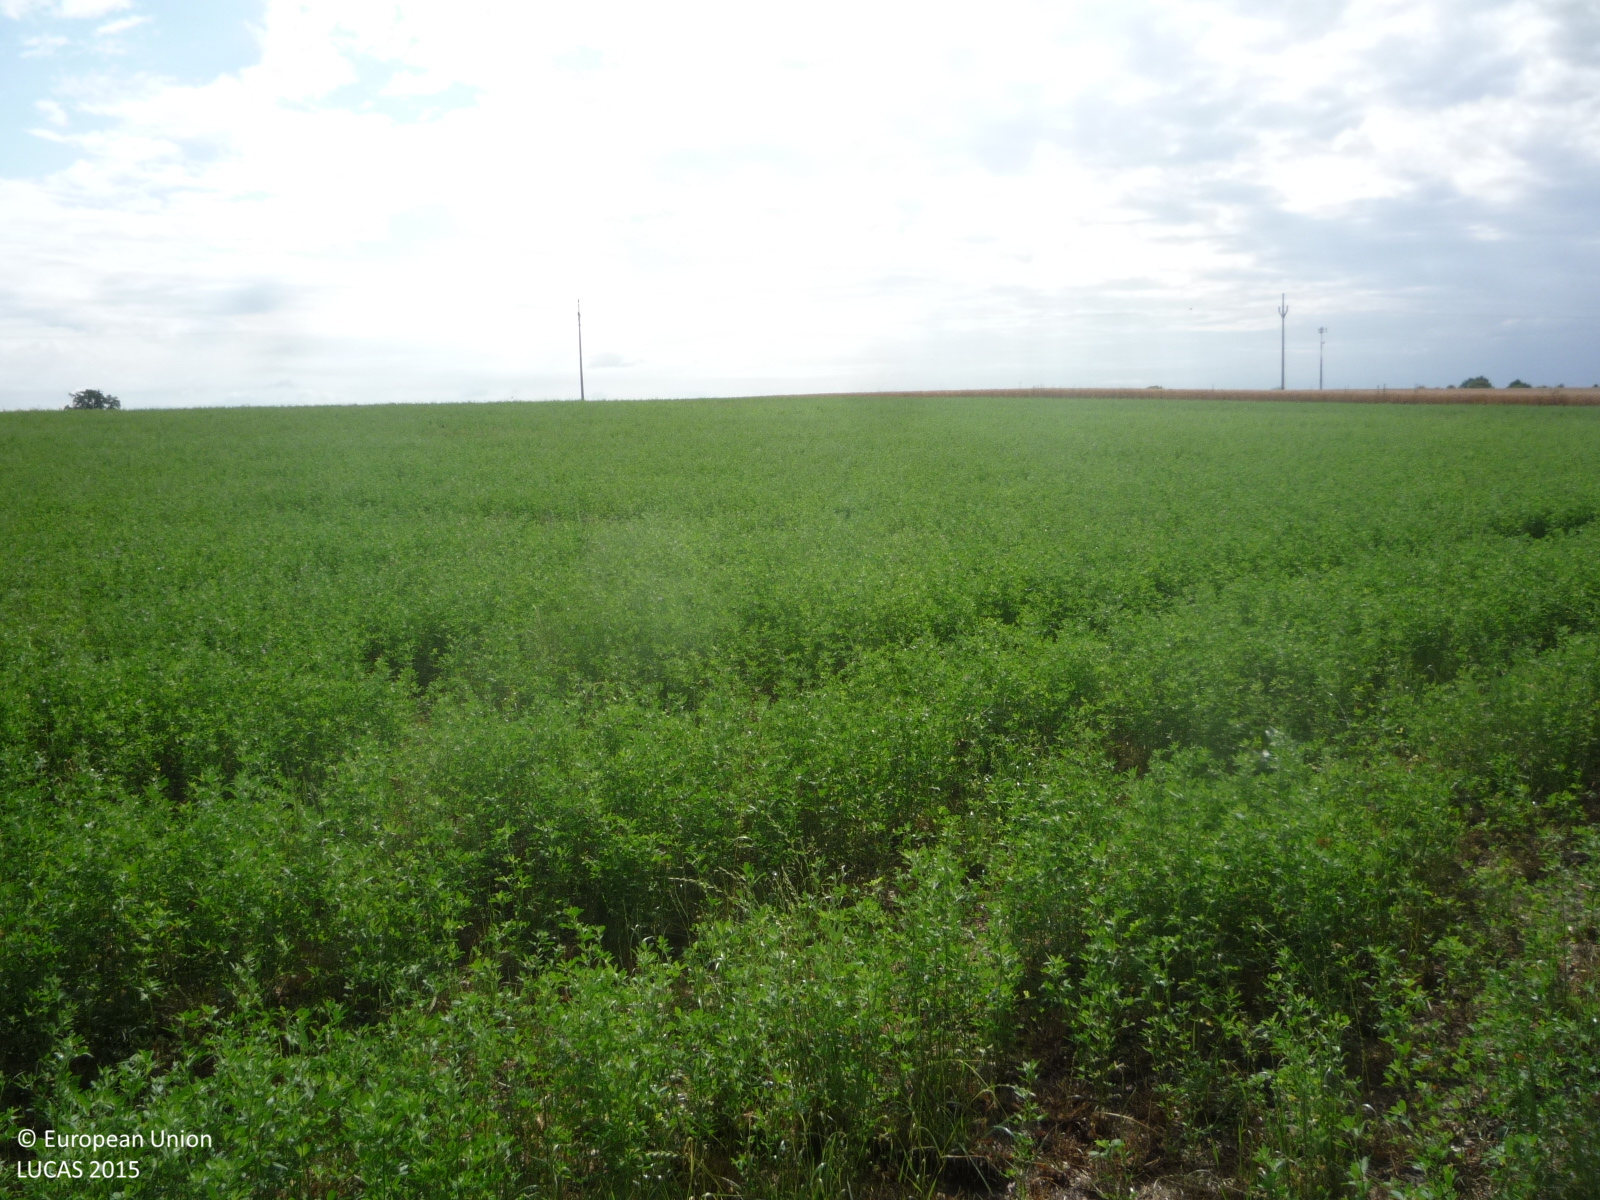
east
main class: Cropland
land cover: Lucerne
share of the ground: > 75 %
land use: Agriculture (excluding fallow land and kitchen gardens)
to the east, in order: Lucerne; Common wheat; Electric lines; Common wheat
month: July
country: CZ
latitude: 50.3903
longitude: 15.1935
